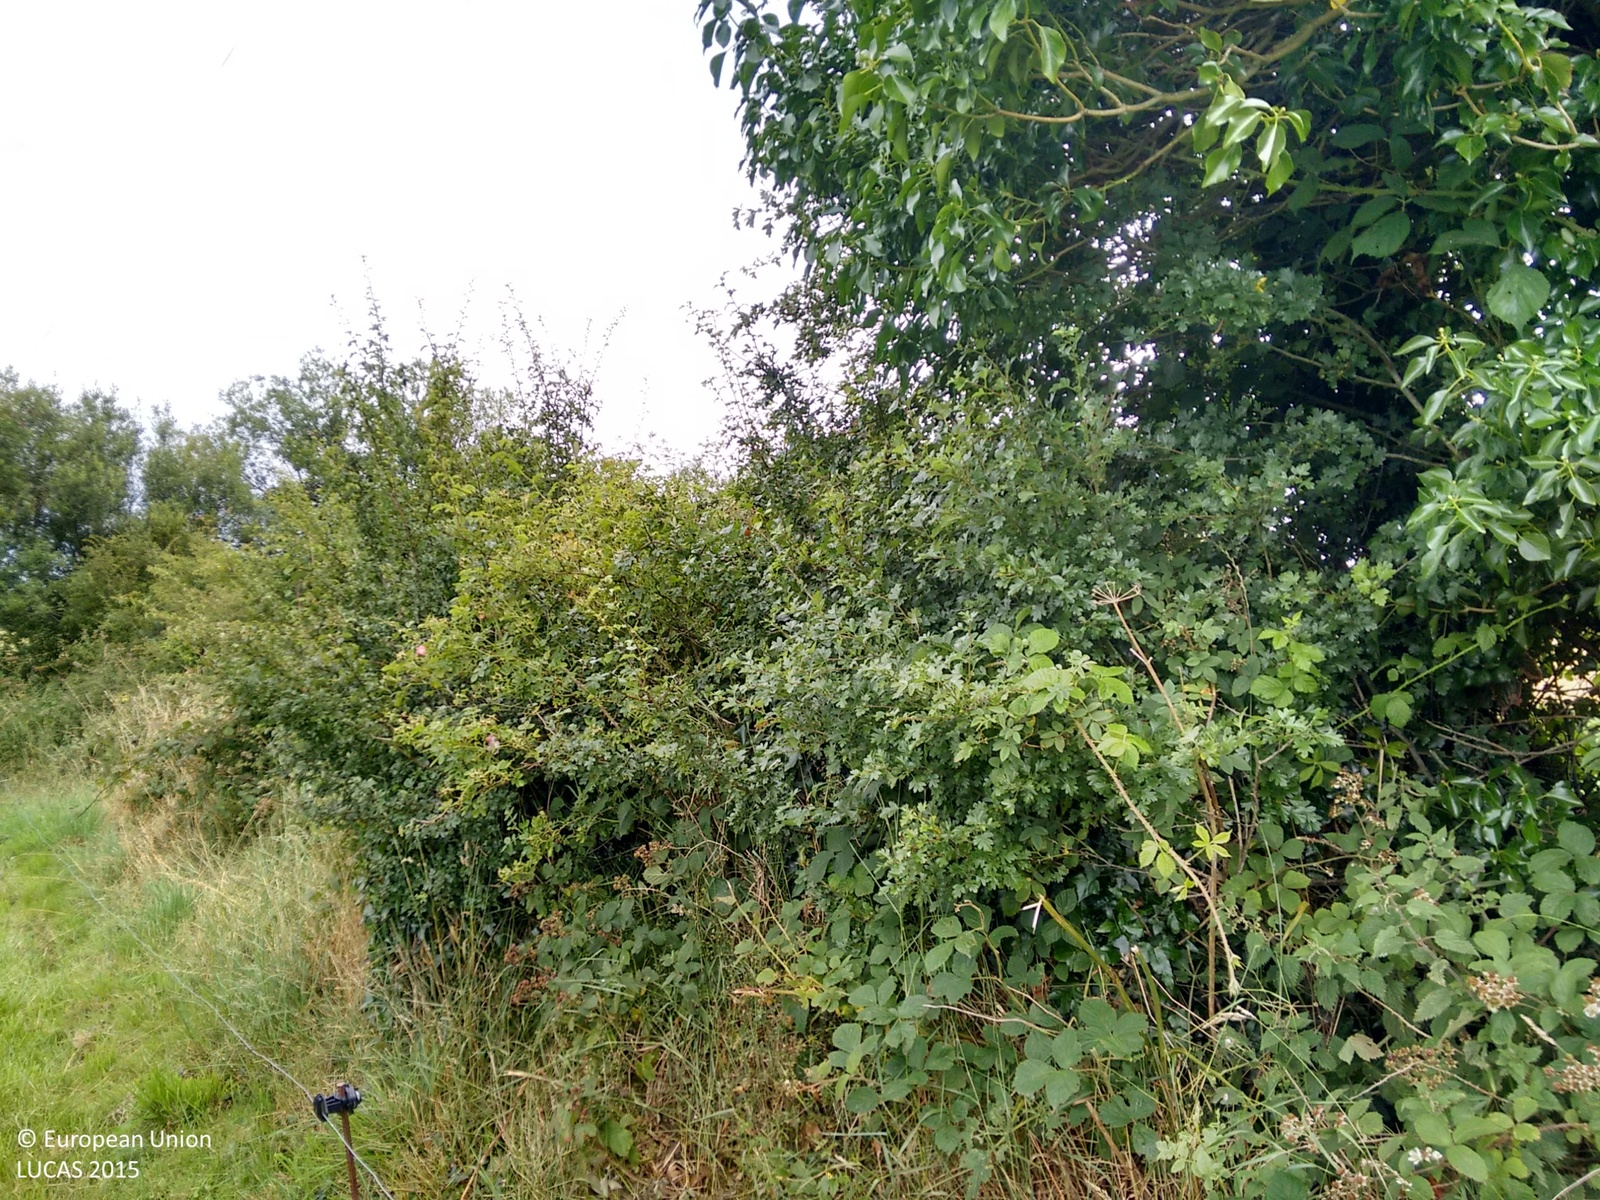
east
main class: Grassland
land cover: Grassland without tree/shrub cover
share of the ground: > 75 %
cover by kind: herbaceous plants 95 %, unconsolidated bare surface 5 %
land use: Agriculture (excluding fallow land and kitchen gardens)
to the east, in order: Grassland without tree/shrub cover; Fences; Abandoned hedges; Fences; Electric lines; Grassland without tree/shrub cover; Fences; Abandoned hedges; Common wheat; Managed hedges; Ditches and canals; Grass margins; Paved roads, cycling and walking lanes; Grass margins; Ditches and canals; Managed hedges; Electric lines; Barley; Electric lines; Barley; Grass margins; Tracks; Grass margins; Broadleaved woodland; Grass margins; Tracks; Barley
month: August
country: IE
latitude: 52.6406
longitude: -6.3952
